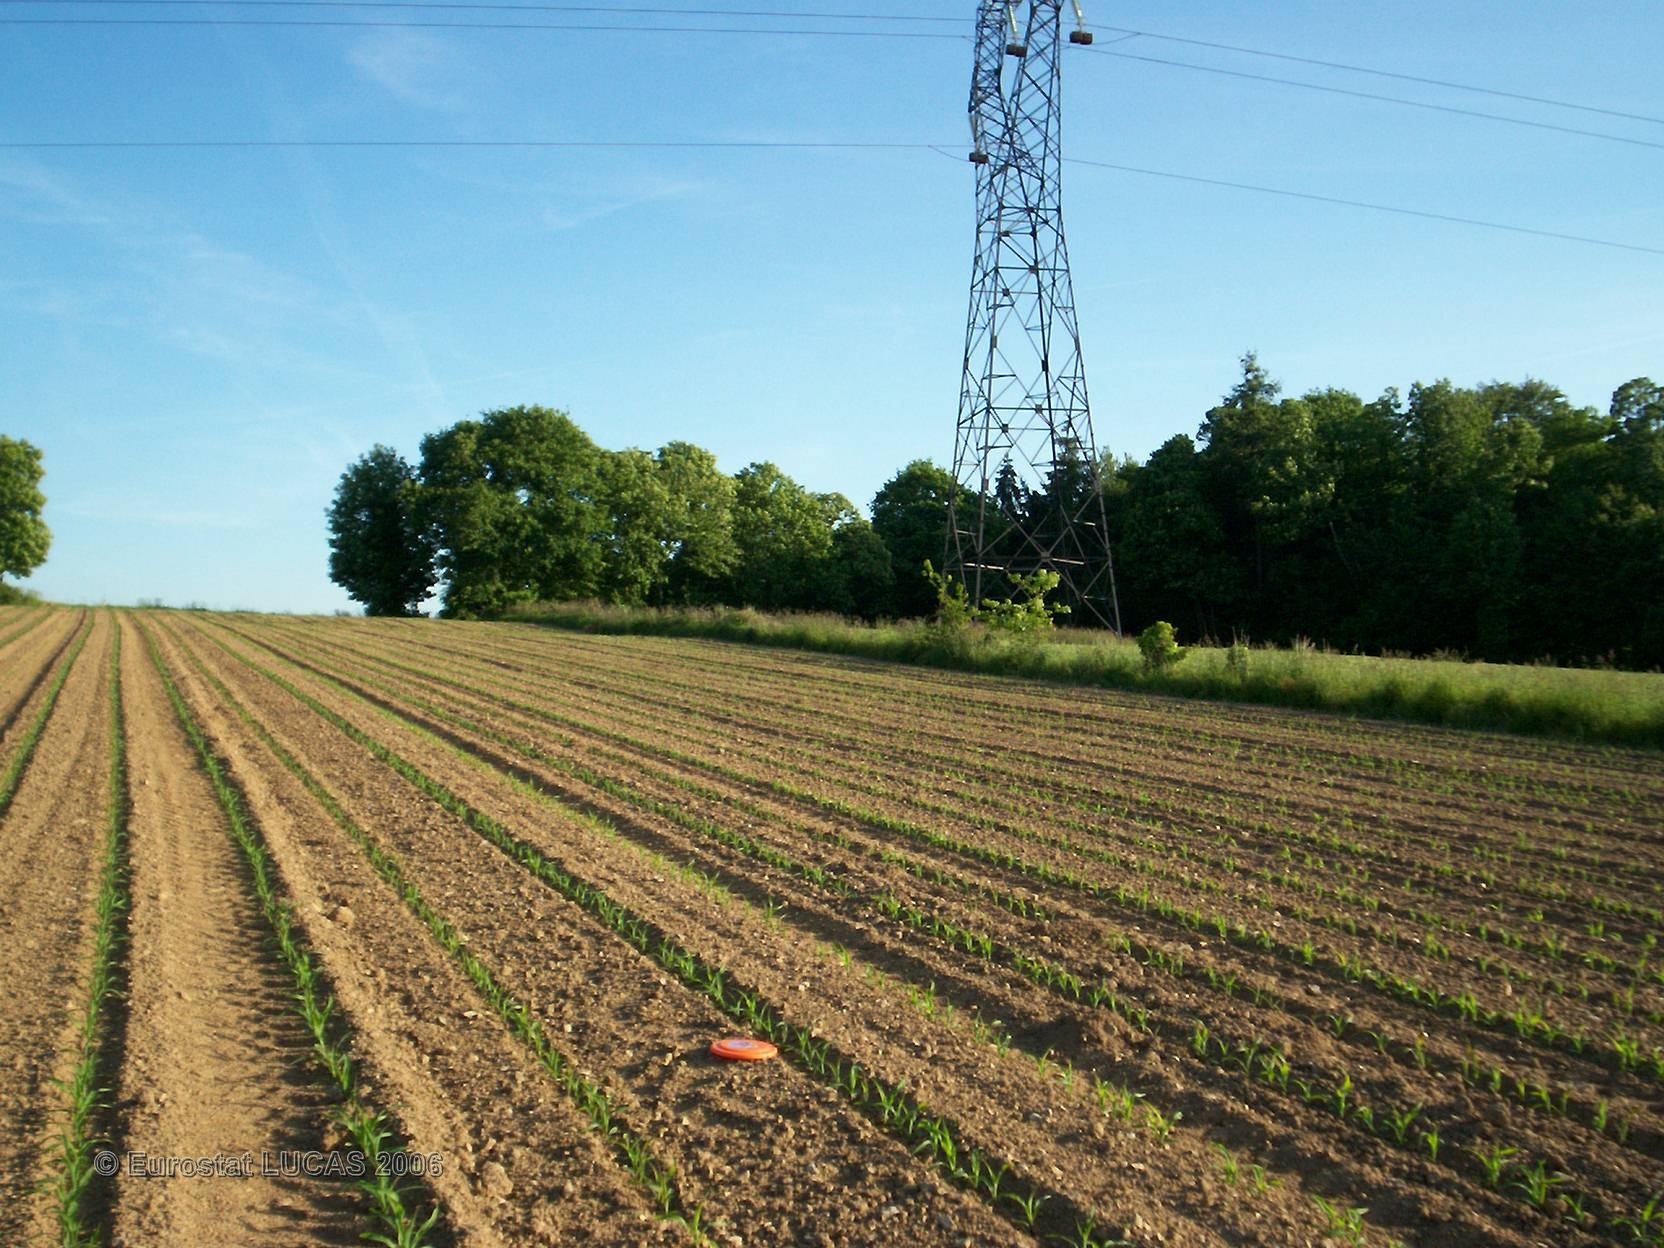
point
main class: Cropland
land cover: Maize
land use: Agriculture (excluding fallow land and kitchen gardens)
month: June
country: FR
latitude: 48.5067
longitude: -1.7039
